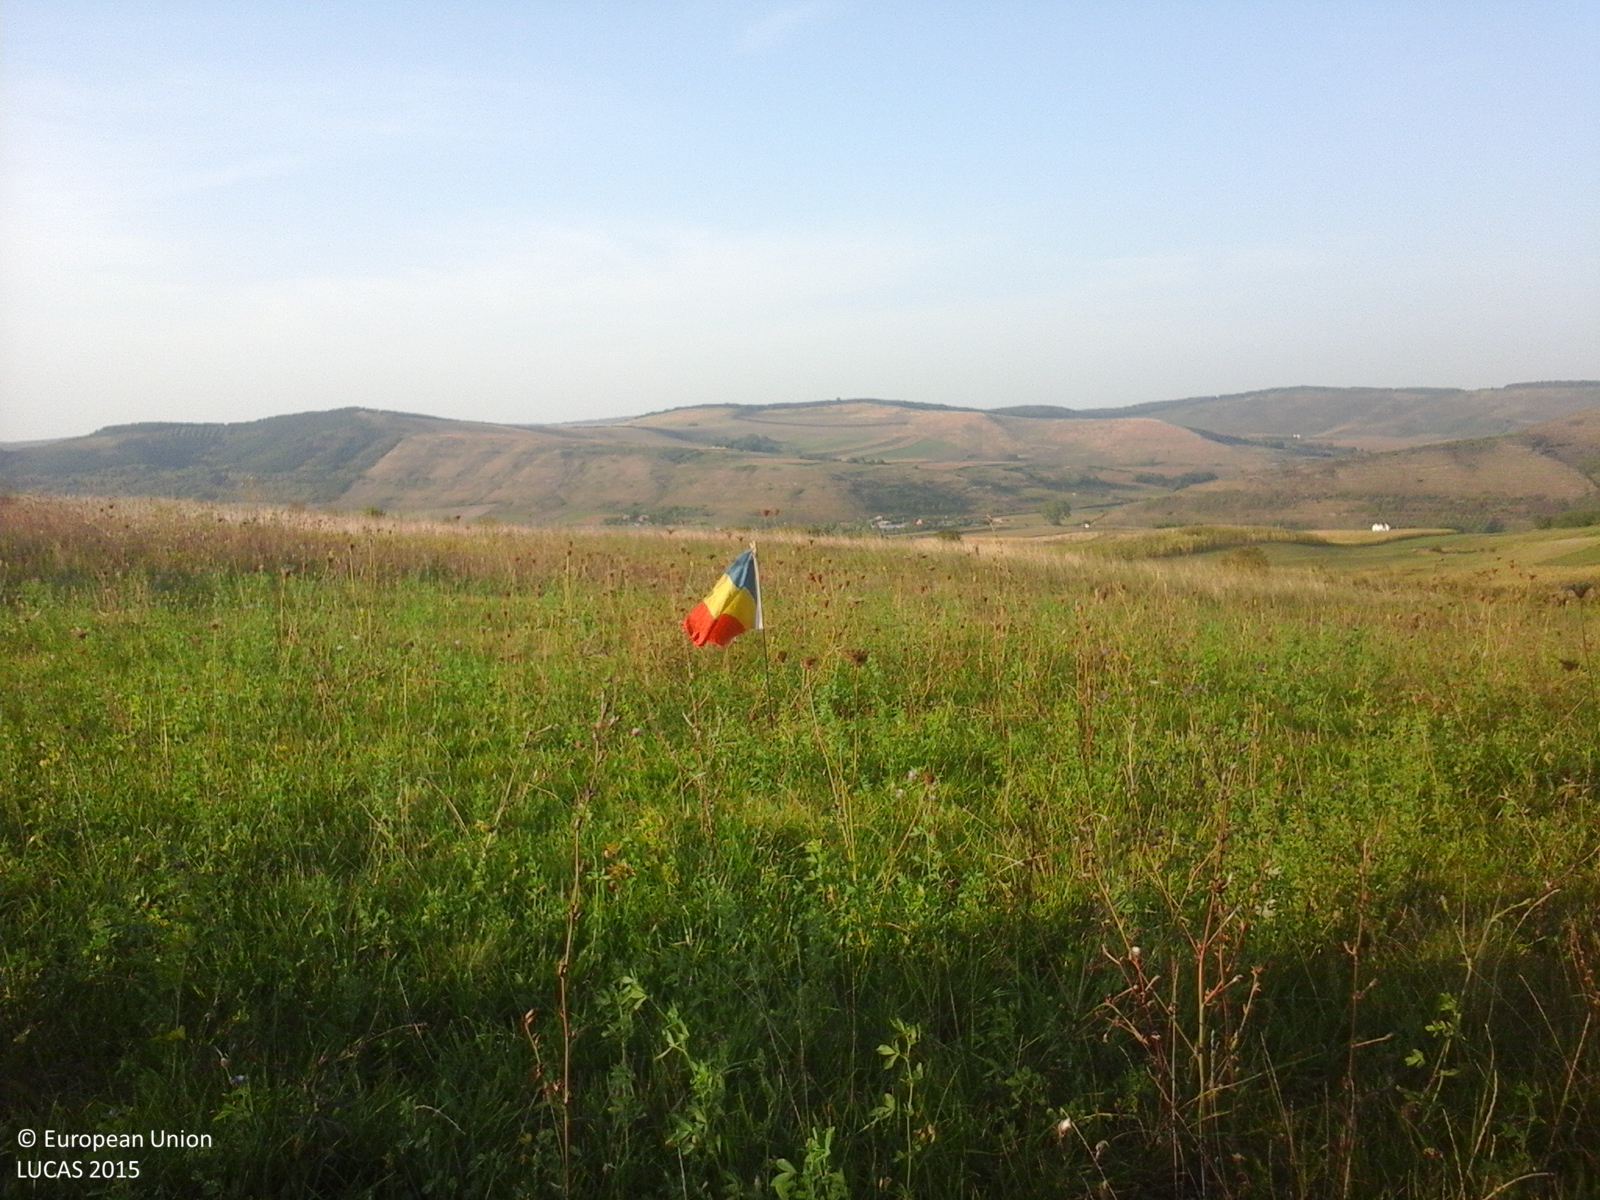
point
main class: Cropland
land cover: Lucerne
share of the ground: > 75 %
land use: Agriculture (excluding fallow land and kitchen gardens)
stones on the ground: < 10 %
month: September
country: RO
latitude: 46.7834
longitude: 23.9490
